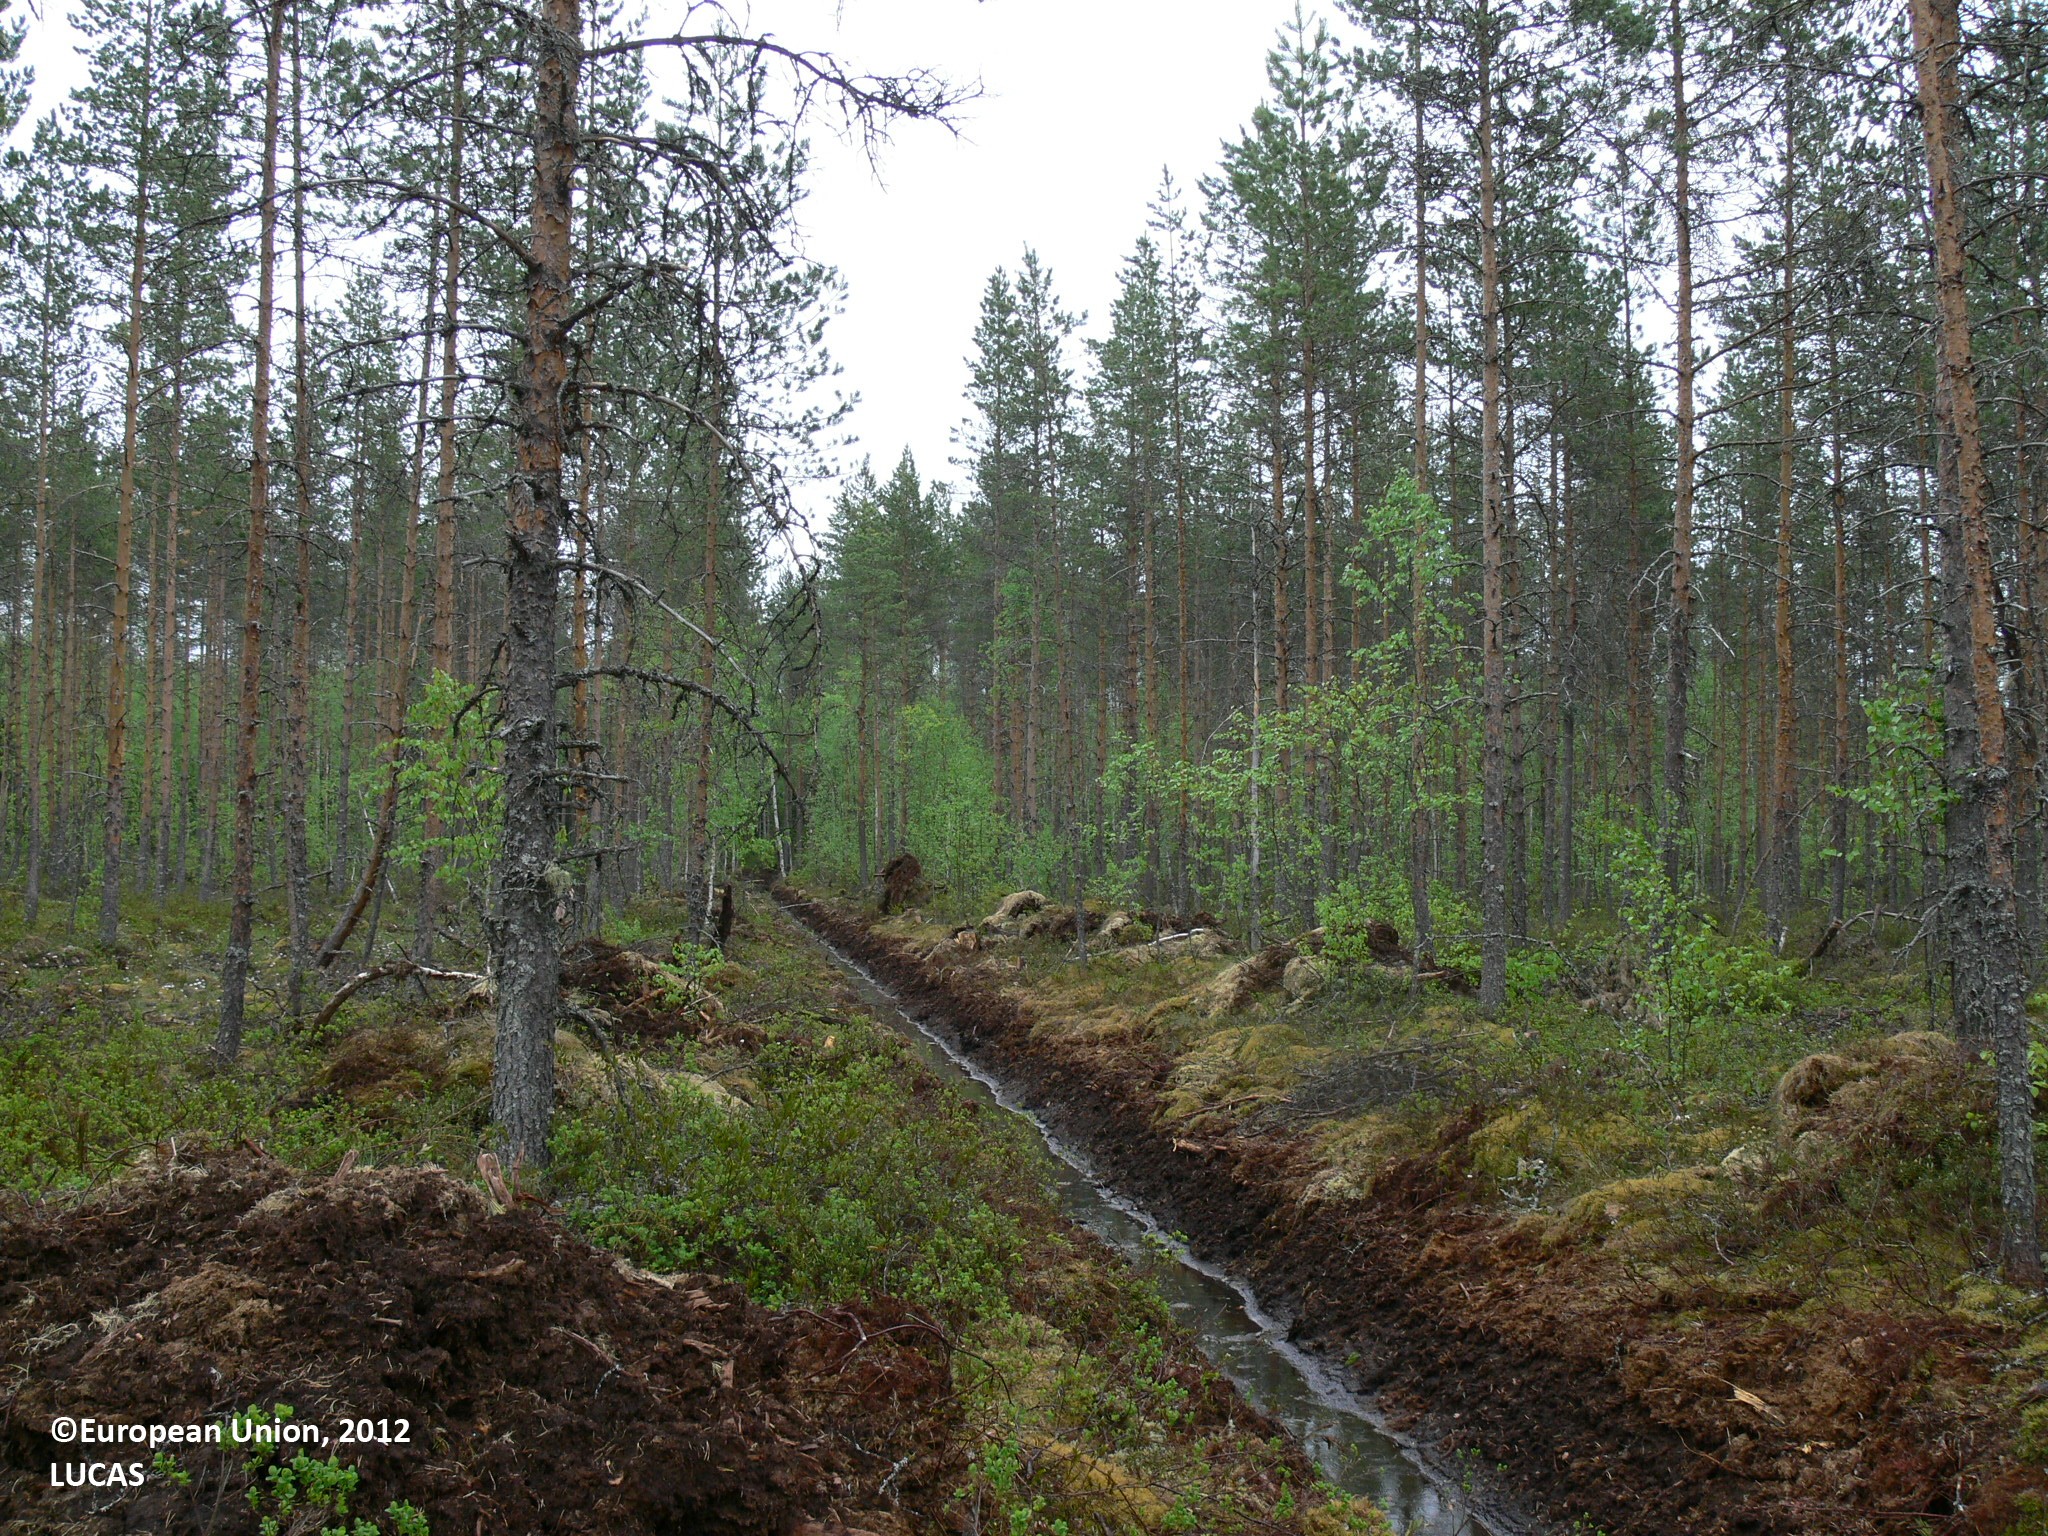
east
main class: Woodland
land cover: Pine dominated coniferous woodland
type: boreal forest
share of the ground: > 75 %
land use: Forestry
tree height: > 5 m
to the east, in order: Pine dominated coniferous woodland; Ditches and canals; Pine dominated coniferous woodland; Tracks; Pine dominated coniferous woodland; Pine dominated mixed woodland; Ditches and canals; Pine dominated mixed woodland; Ditches and canals; Pine dominated mixed woodland; Tracks; Other mixed woodland; Ditches and canals; Other mixed woodland; Spruce dominated mixed woodland
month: June
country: FI
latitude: 62.2268
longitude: 30.2219
